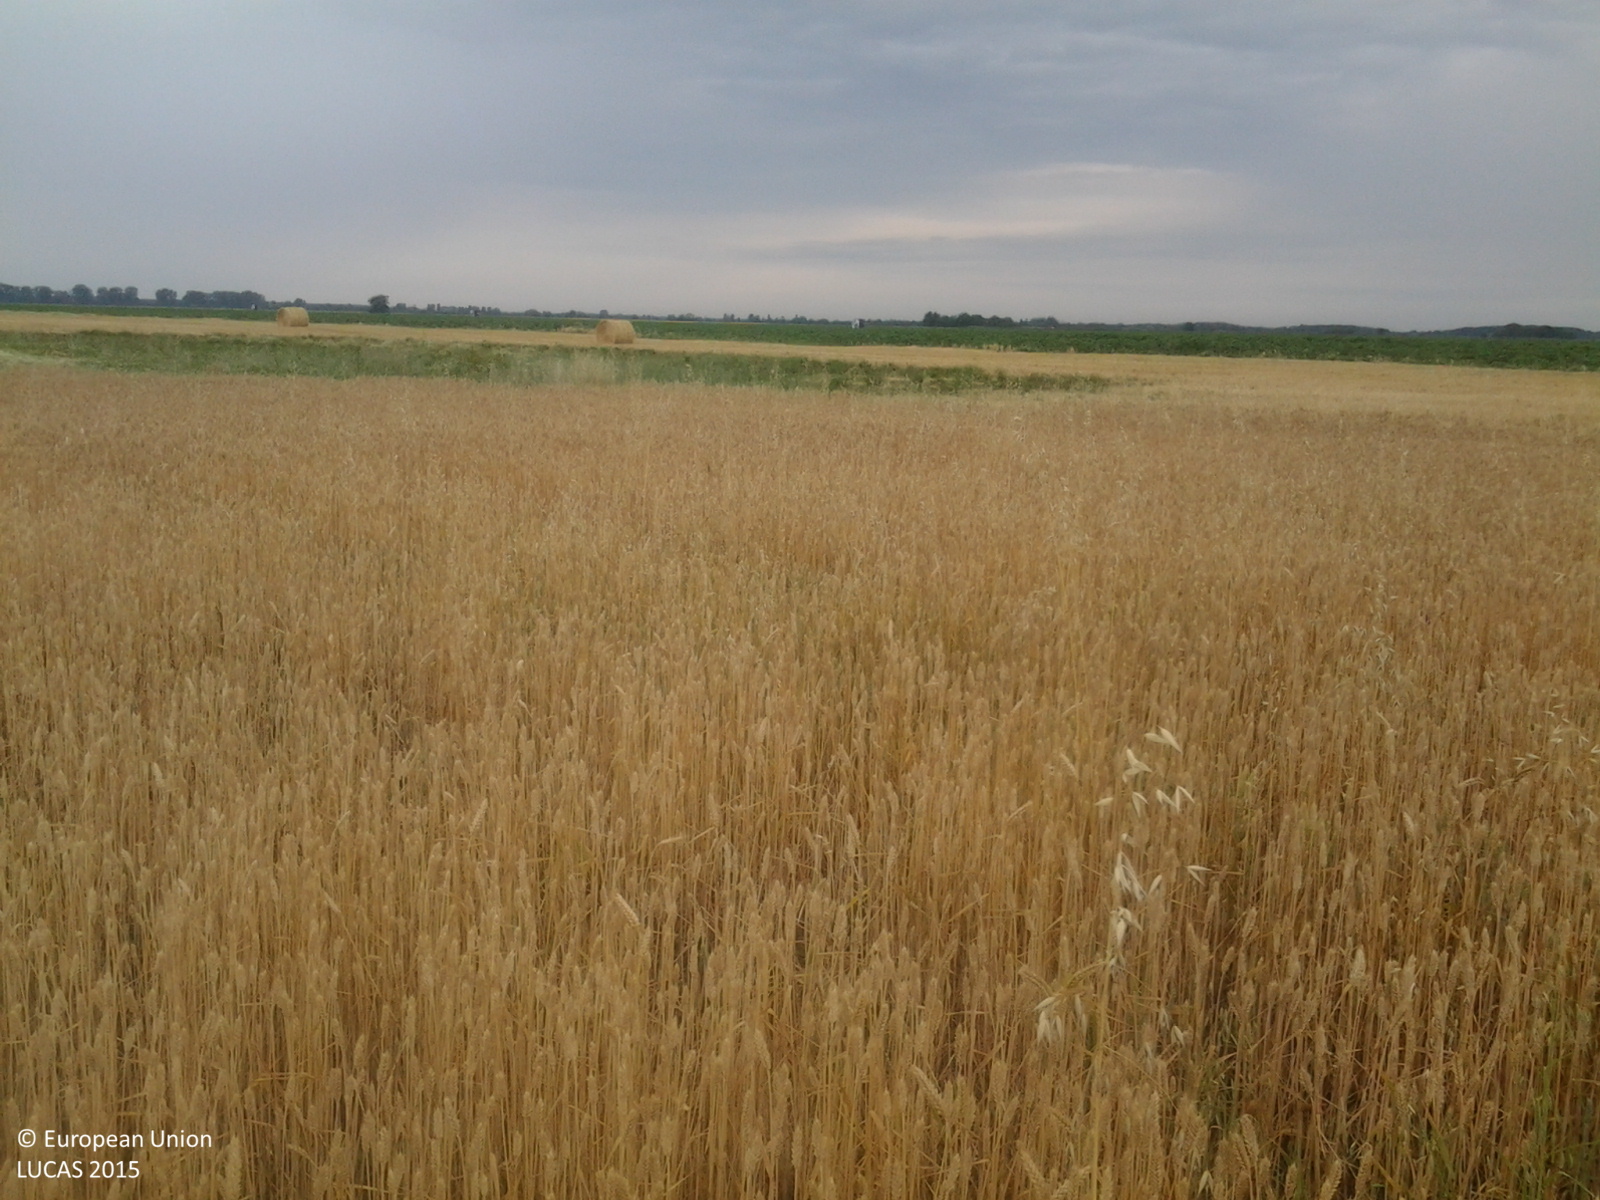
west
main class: Cropland
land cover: Common wheat
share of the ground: > 75 %
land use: Agriculture (excluding fallow land and kitchen gardens)
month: June
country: HU
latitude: 46.8566
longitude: 20.4286
